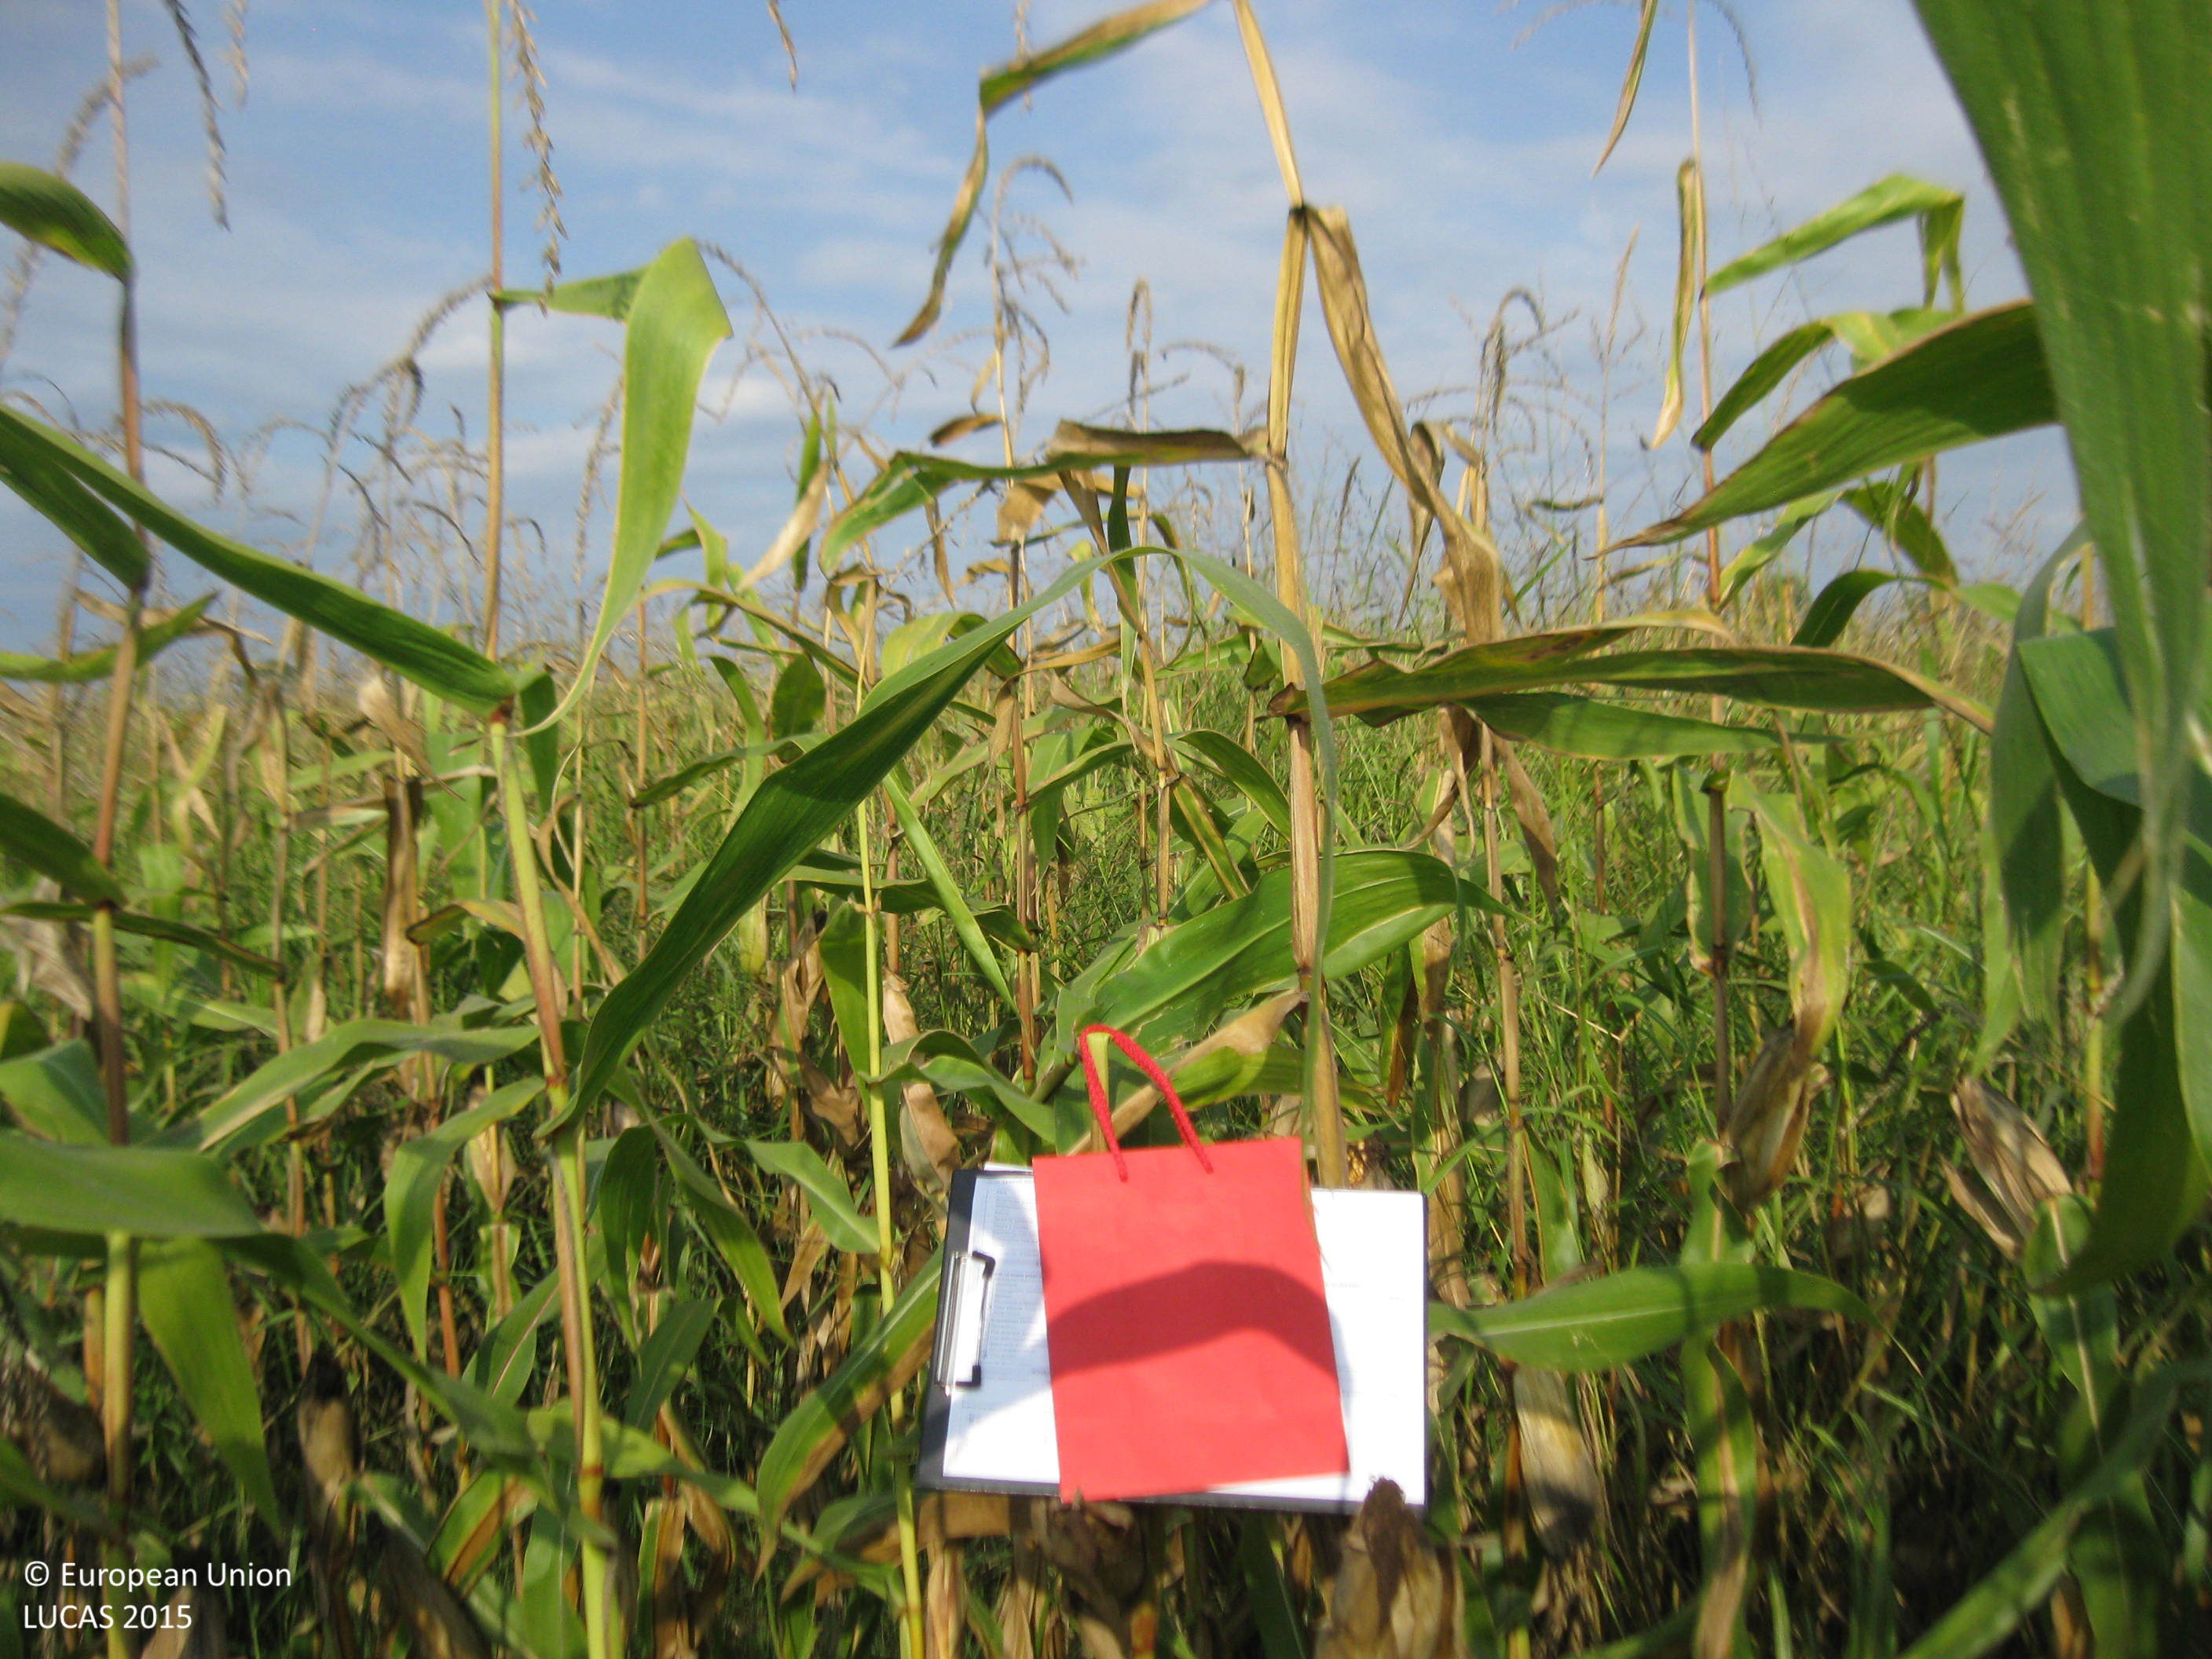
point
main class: Cropland
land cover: Maize
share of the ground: > 75 %
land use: Agriculture (excluding fallow land and kitchen gardens)
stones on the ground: < 10 %
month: September
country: BG
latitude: 42.1598
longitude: 25.0777
